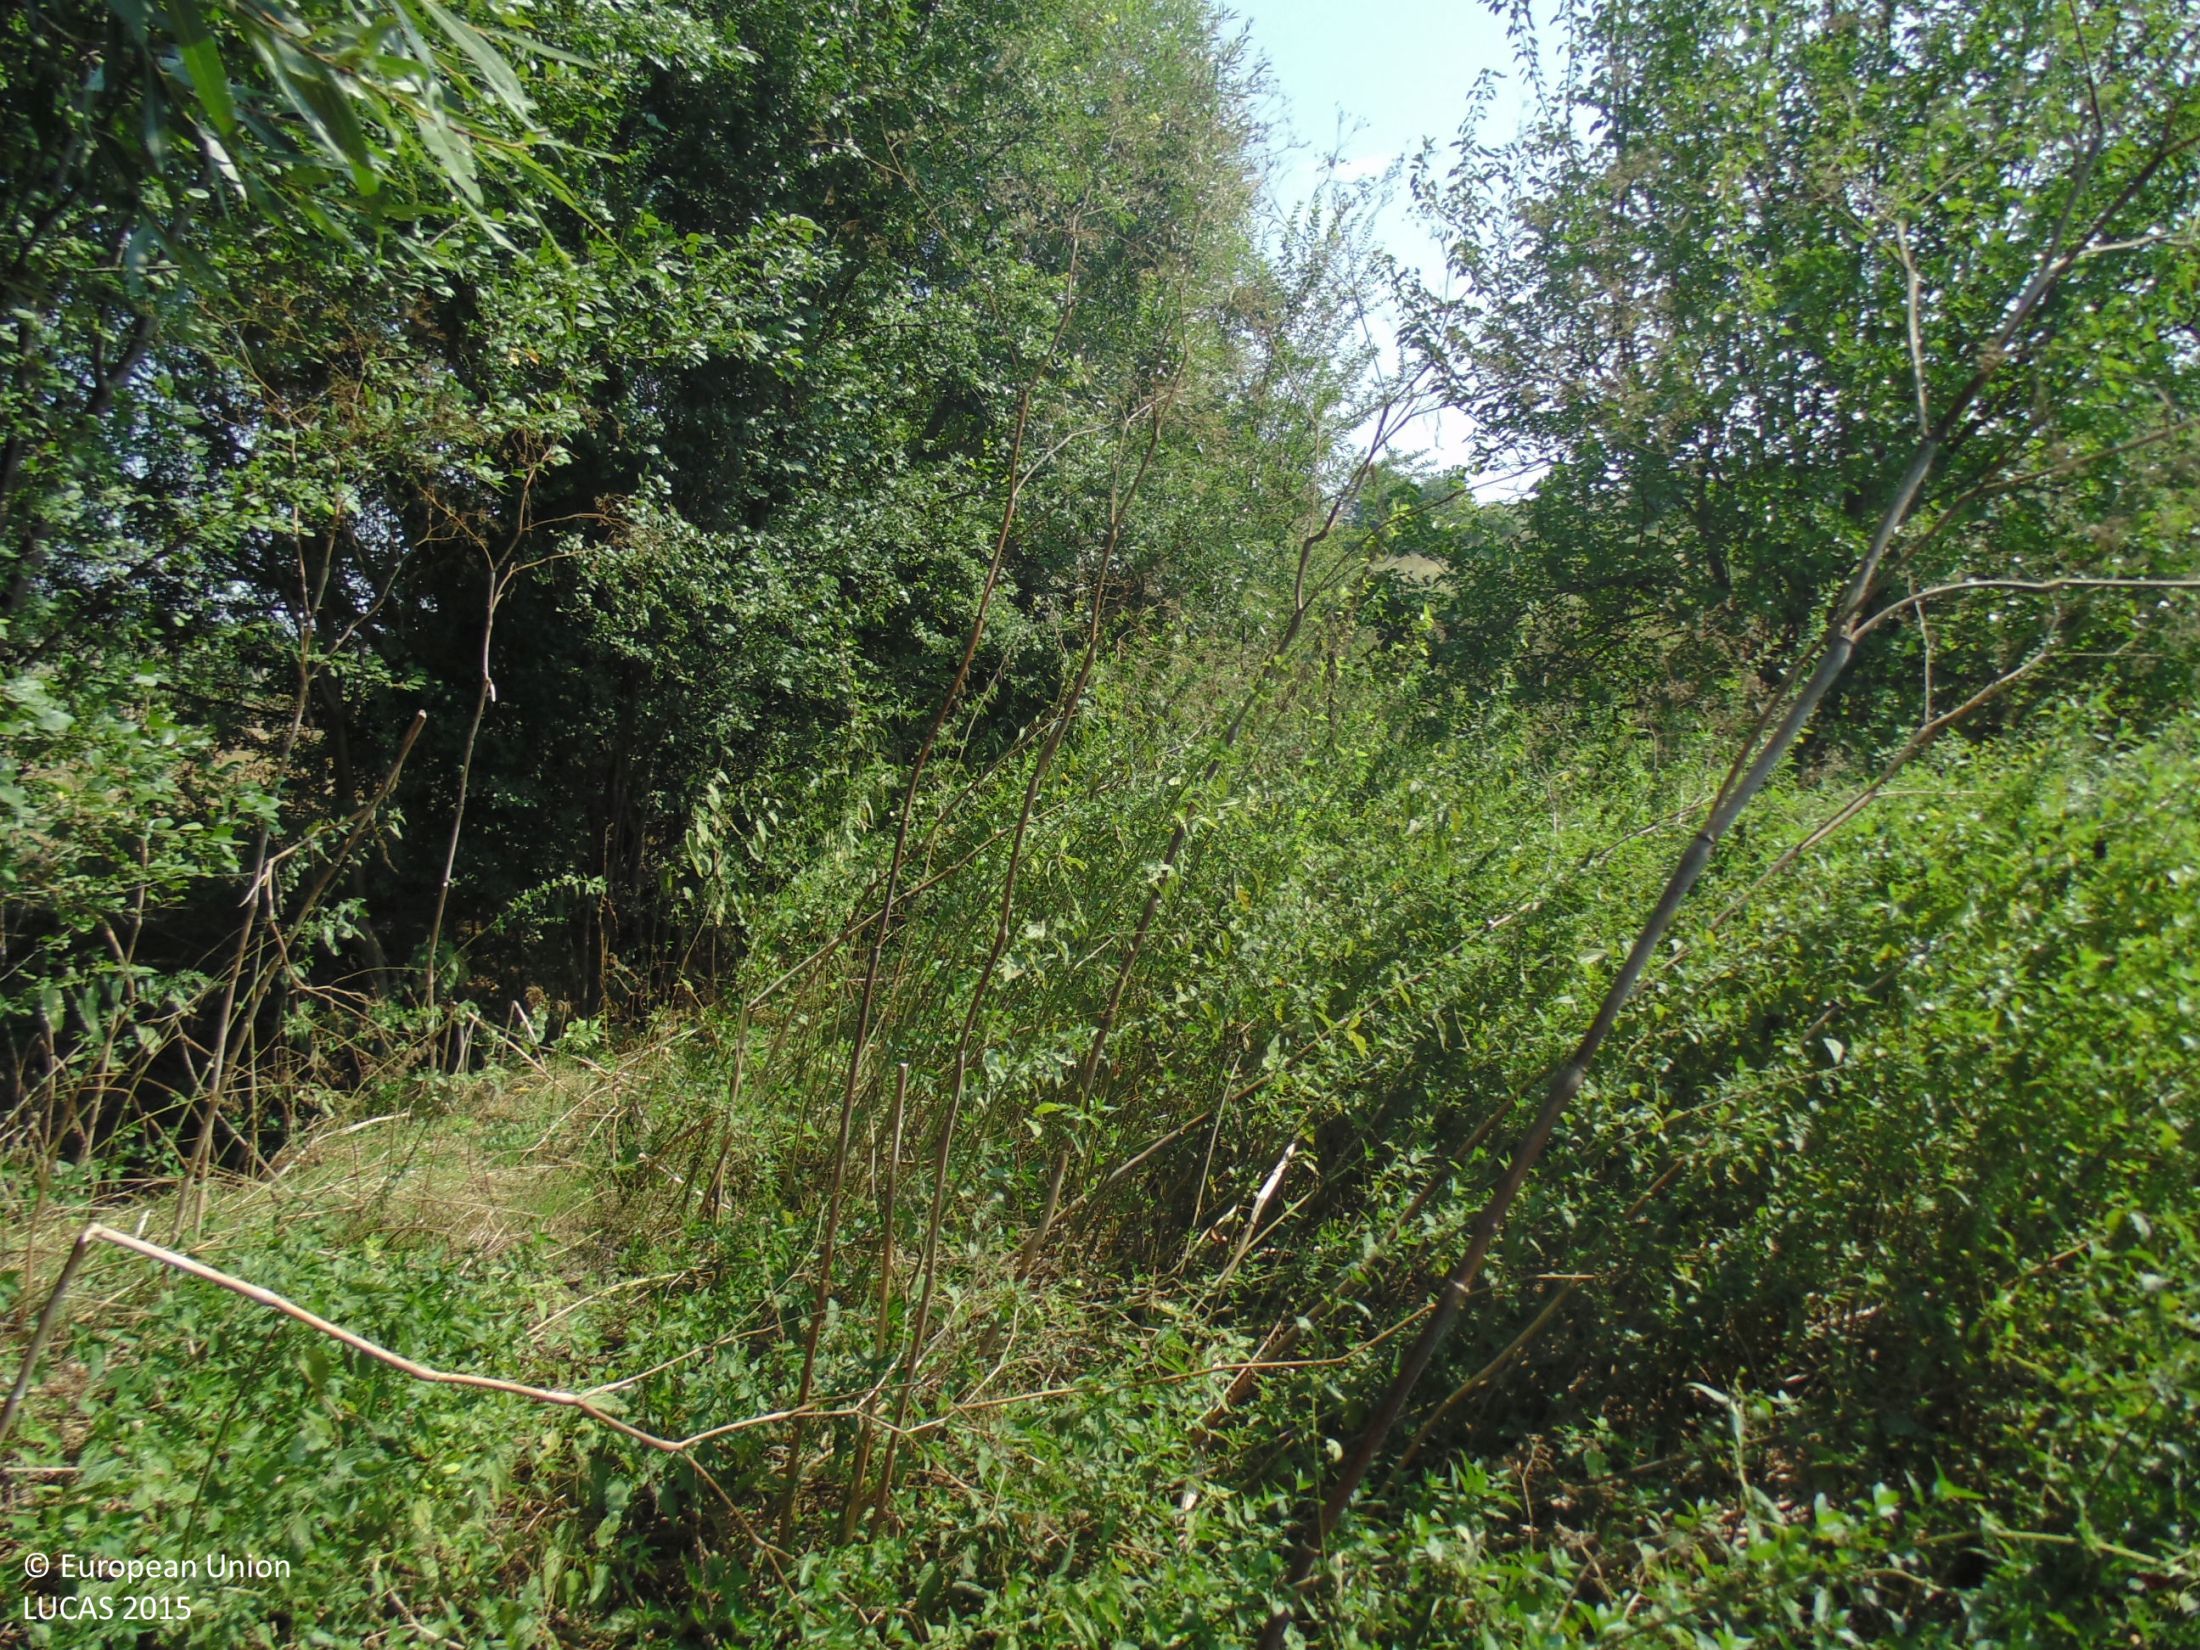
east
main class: Woodland
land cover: Broadleaved woodland
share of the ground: 50 - 75 %
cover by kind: broadleaved forest trees 50 %, herbaceous plants 45 %, shrubs 5 %
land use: Semi-natural and natural areas not in use
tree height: > 5 m
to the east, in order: Broadleaved woodland; Ditches and canals; Broadleaved woodland; Ditches and canals; Broadleaved woodland; Grassland without tree/shrub cover; Grassland with sparse tree/shrub cover; Sunflower
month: August
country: BG
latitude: 44.0195
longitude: 27.3357
